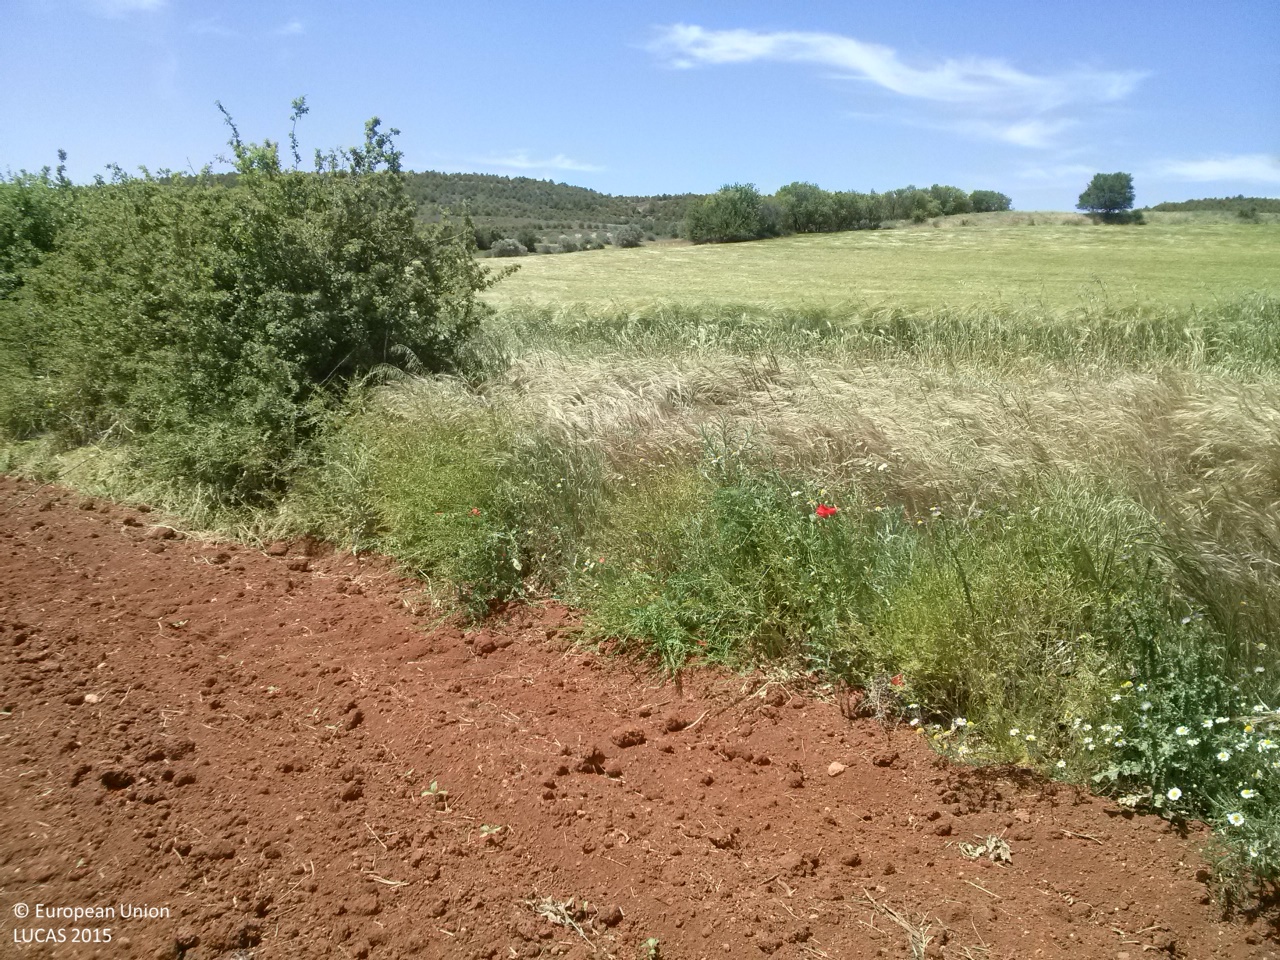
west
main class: Cropland
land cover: Sunflower
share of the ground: < 10 %
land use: Agriculture (excluding fallow land and kitchen gardens)
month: May
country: ES
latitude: 40.0428
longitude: -2.8329
